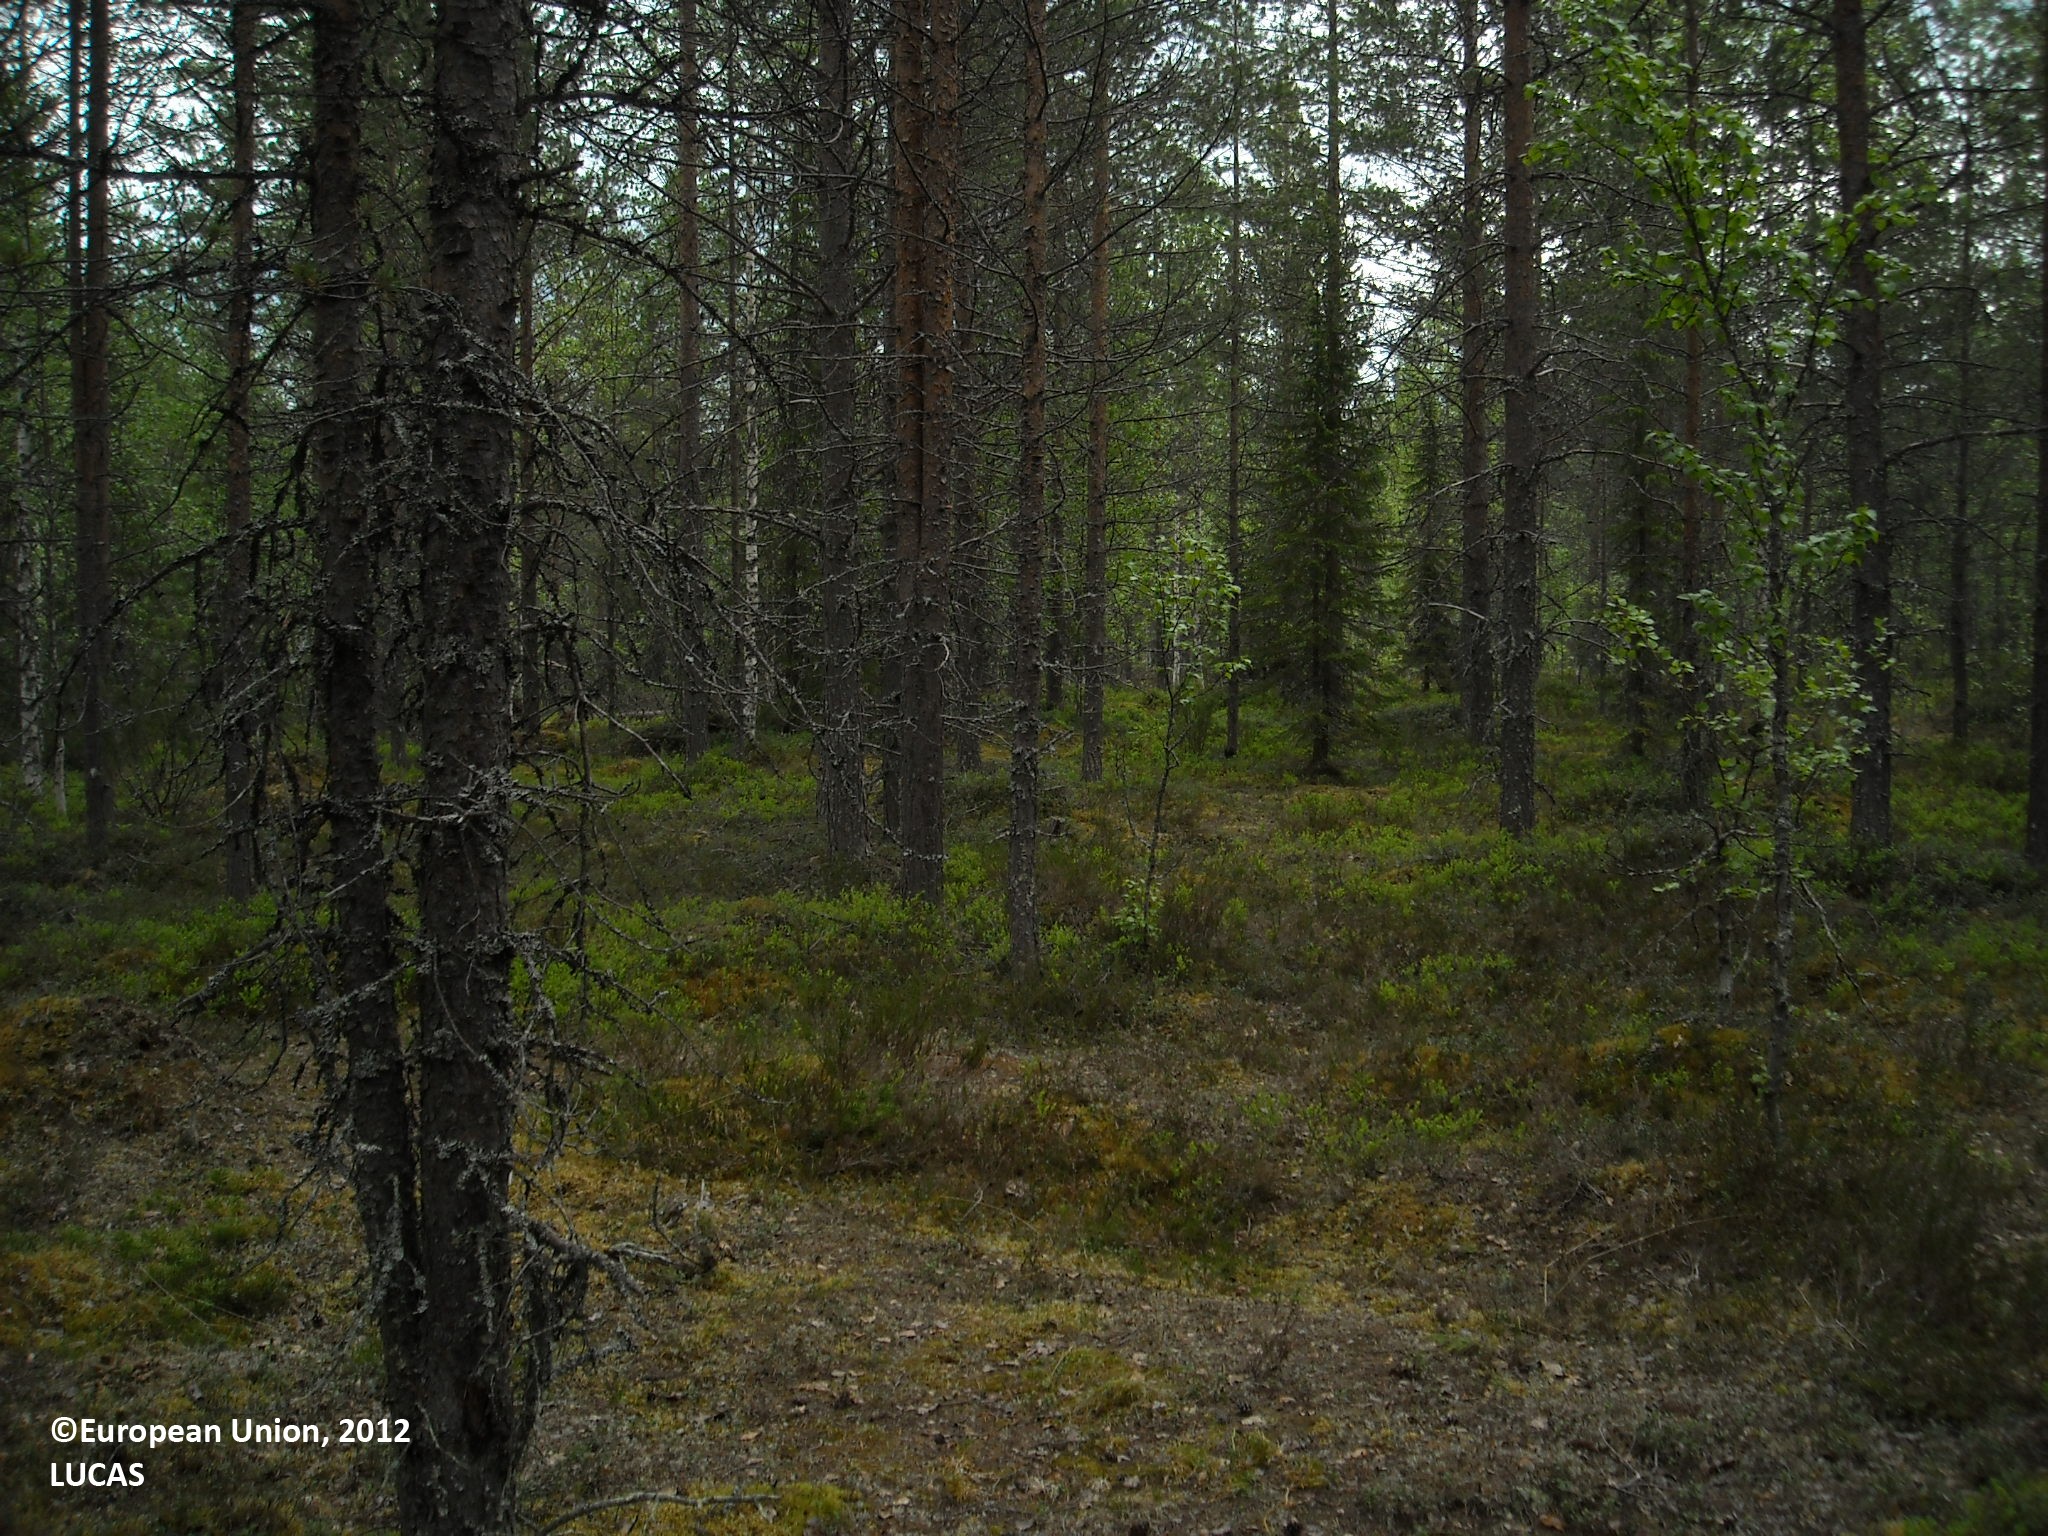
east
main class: Woodland
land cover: Pine dominated mixed woodland
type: boreal forest
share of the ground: > 75 %
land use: Forestry
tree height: > 5 m
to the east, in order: Pine dominated mixed woodland; Ditches and canals; Abandoned hedges; Paved roads, cycling and walking lanes; Pine dominated mixed woodland
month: June
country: FI
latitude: 65.5723
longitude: 28.0233
